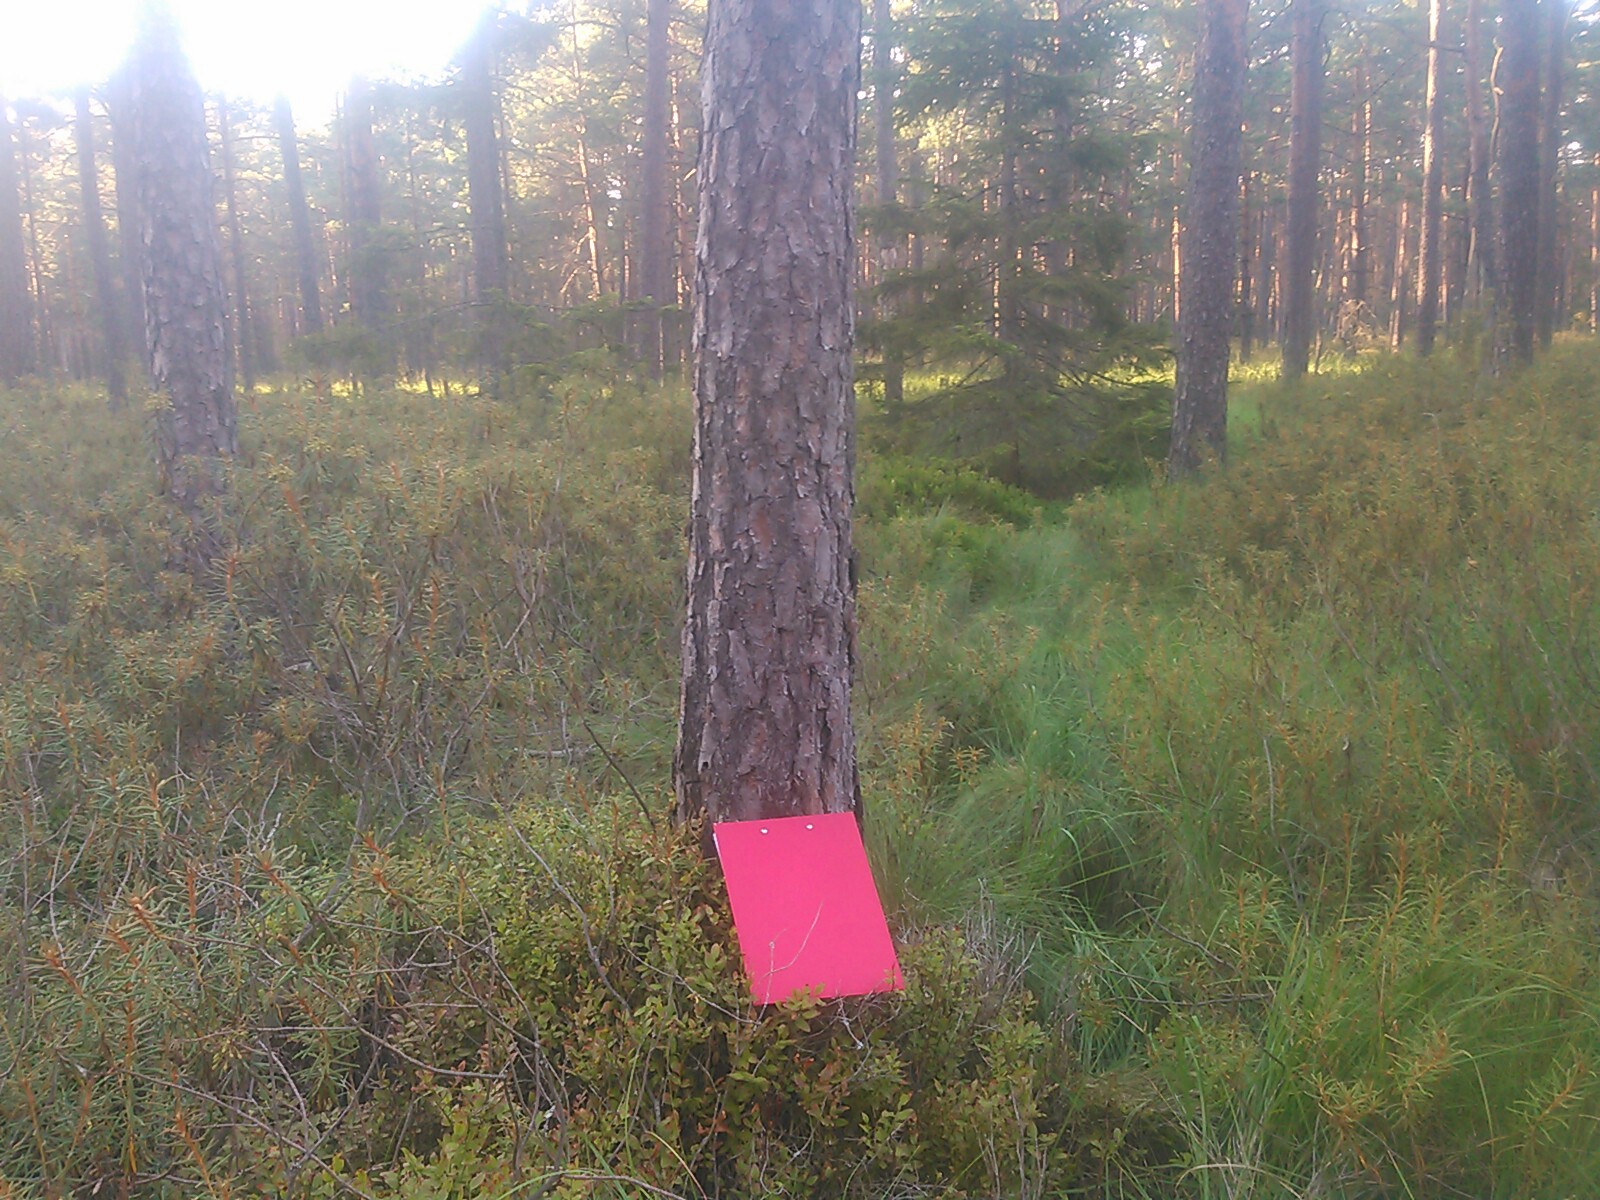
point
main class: Woodland
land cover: Pine dominated coniferous woodland
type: hemiboreal forest and nemoral coniferous forest and mixed broadleaved-coniferous forest
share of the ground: 50 - 75 %
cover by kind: coniferous forest trees 65 %, shrubs 30 %, herbaceous plants 5 %
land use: Forestry
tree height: > 5 m
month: August
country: PL
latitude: 53.9089
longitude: 17.2099
